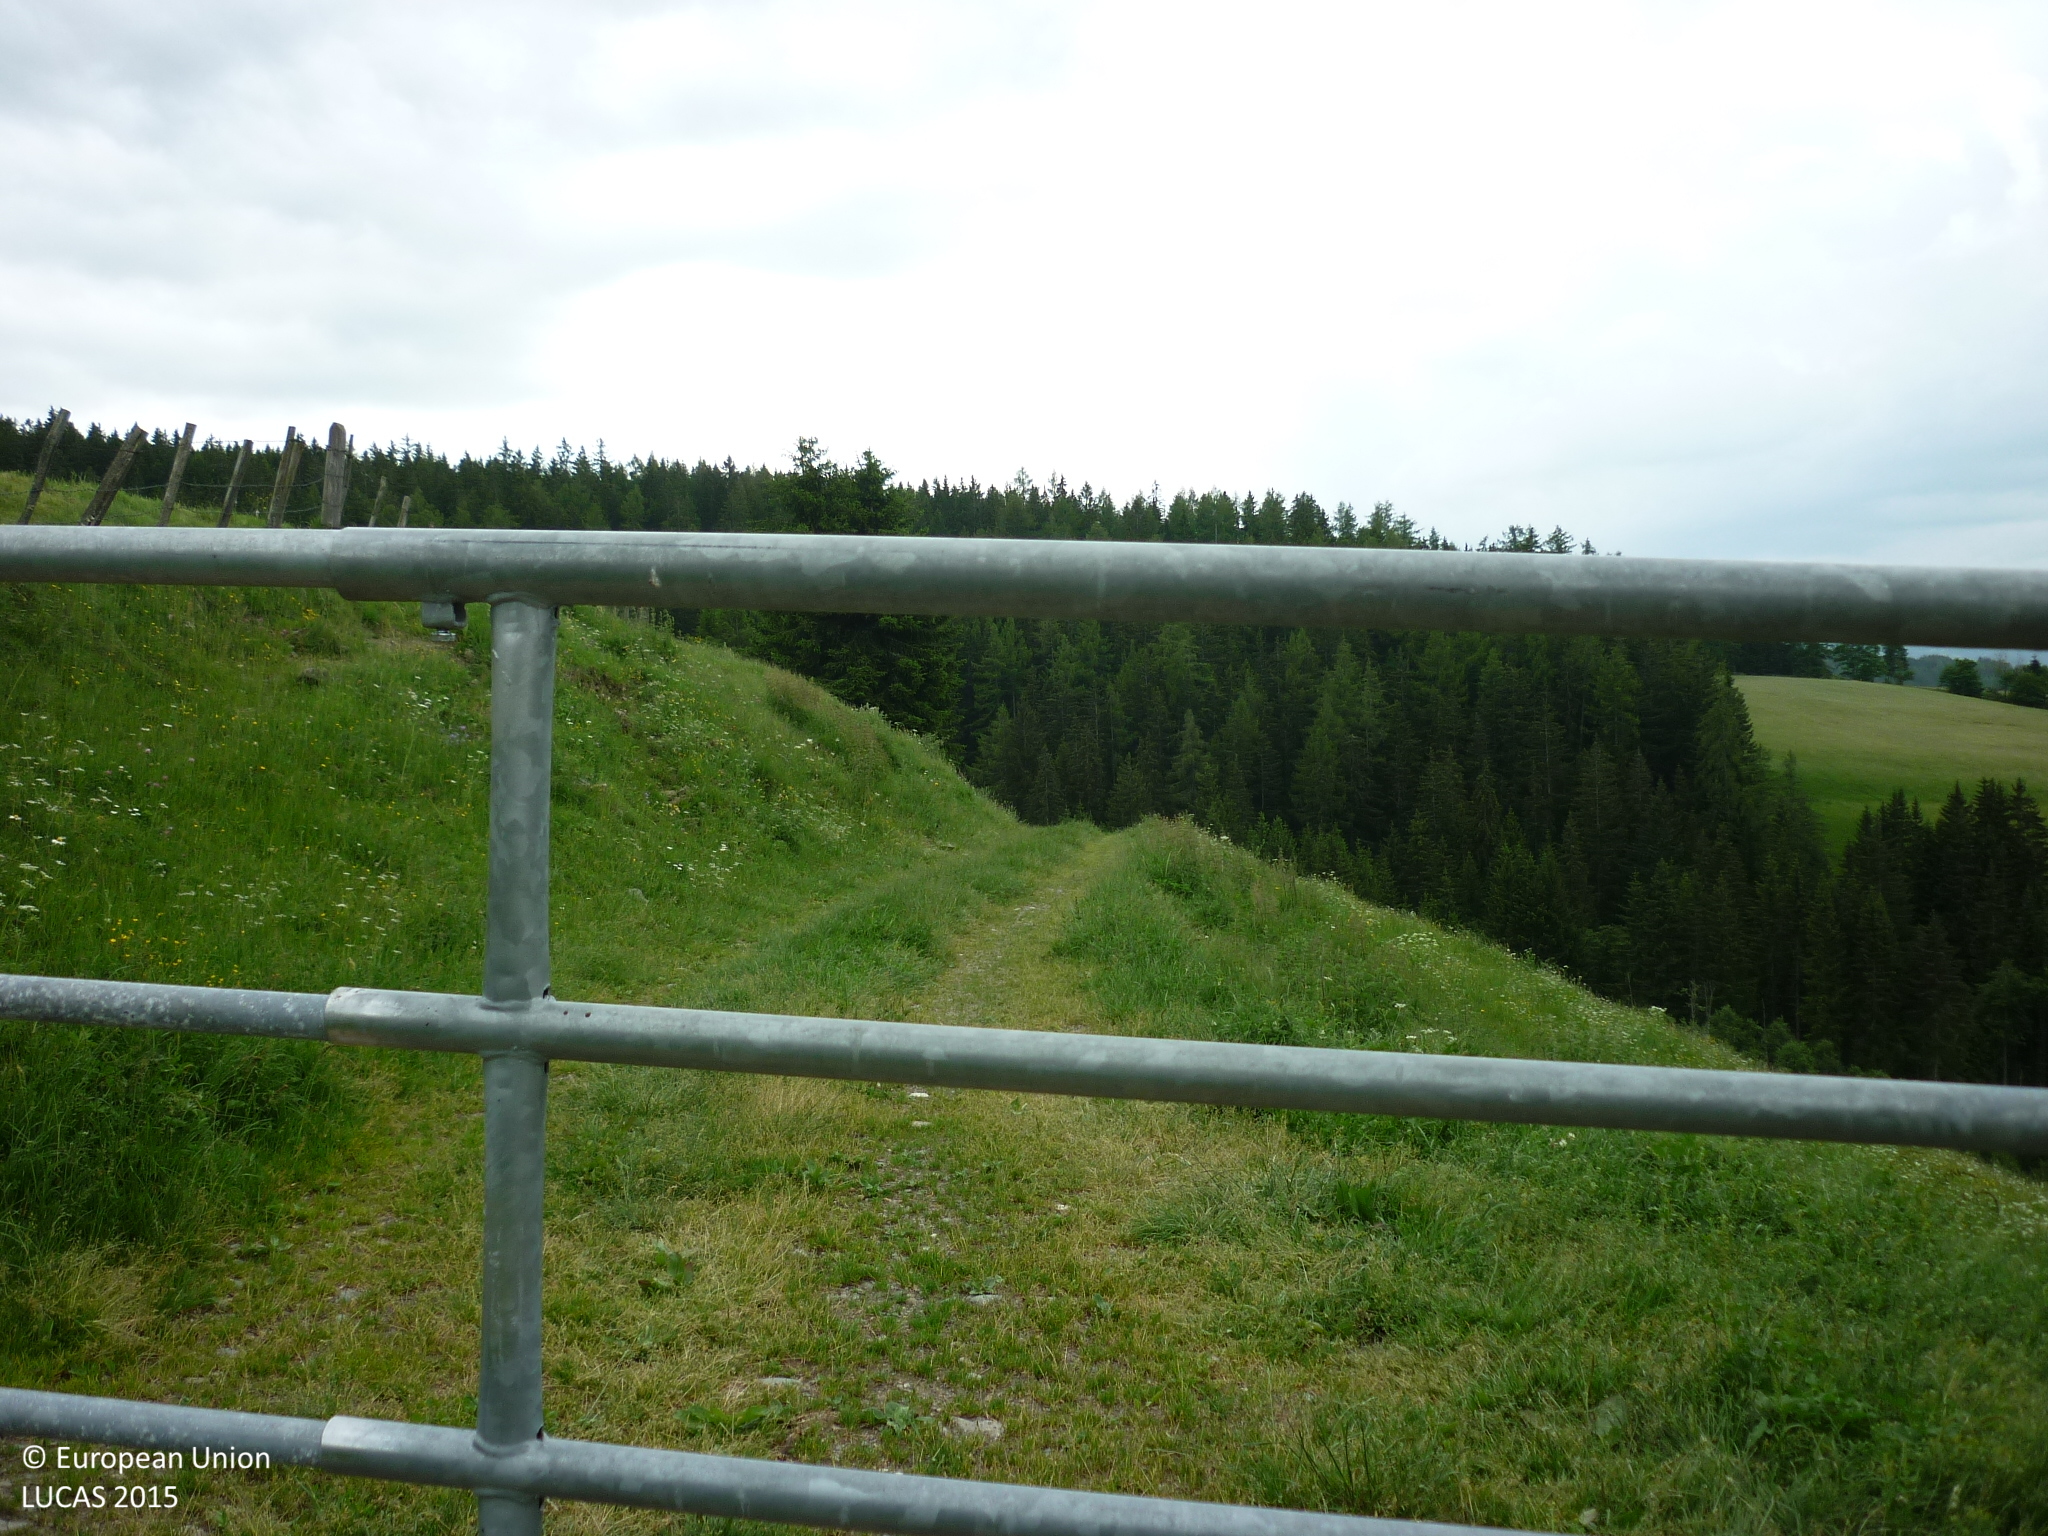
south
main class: Grassland
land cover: Grassland without tree/shrub cover
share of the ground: > 75 %
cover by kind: herbaceous plants 100 %
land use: Agriculture (excluding fallow land and kitchen gardens)
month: June
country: AT
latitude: 47.0866
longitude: 14.4902
